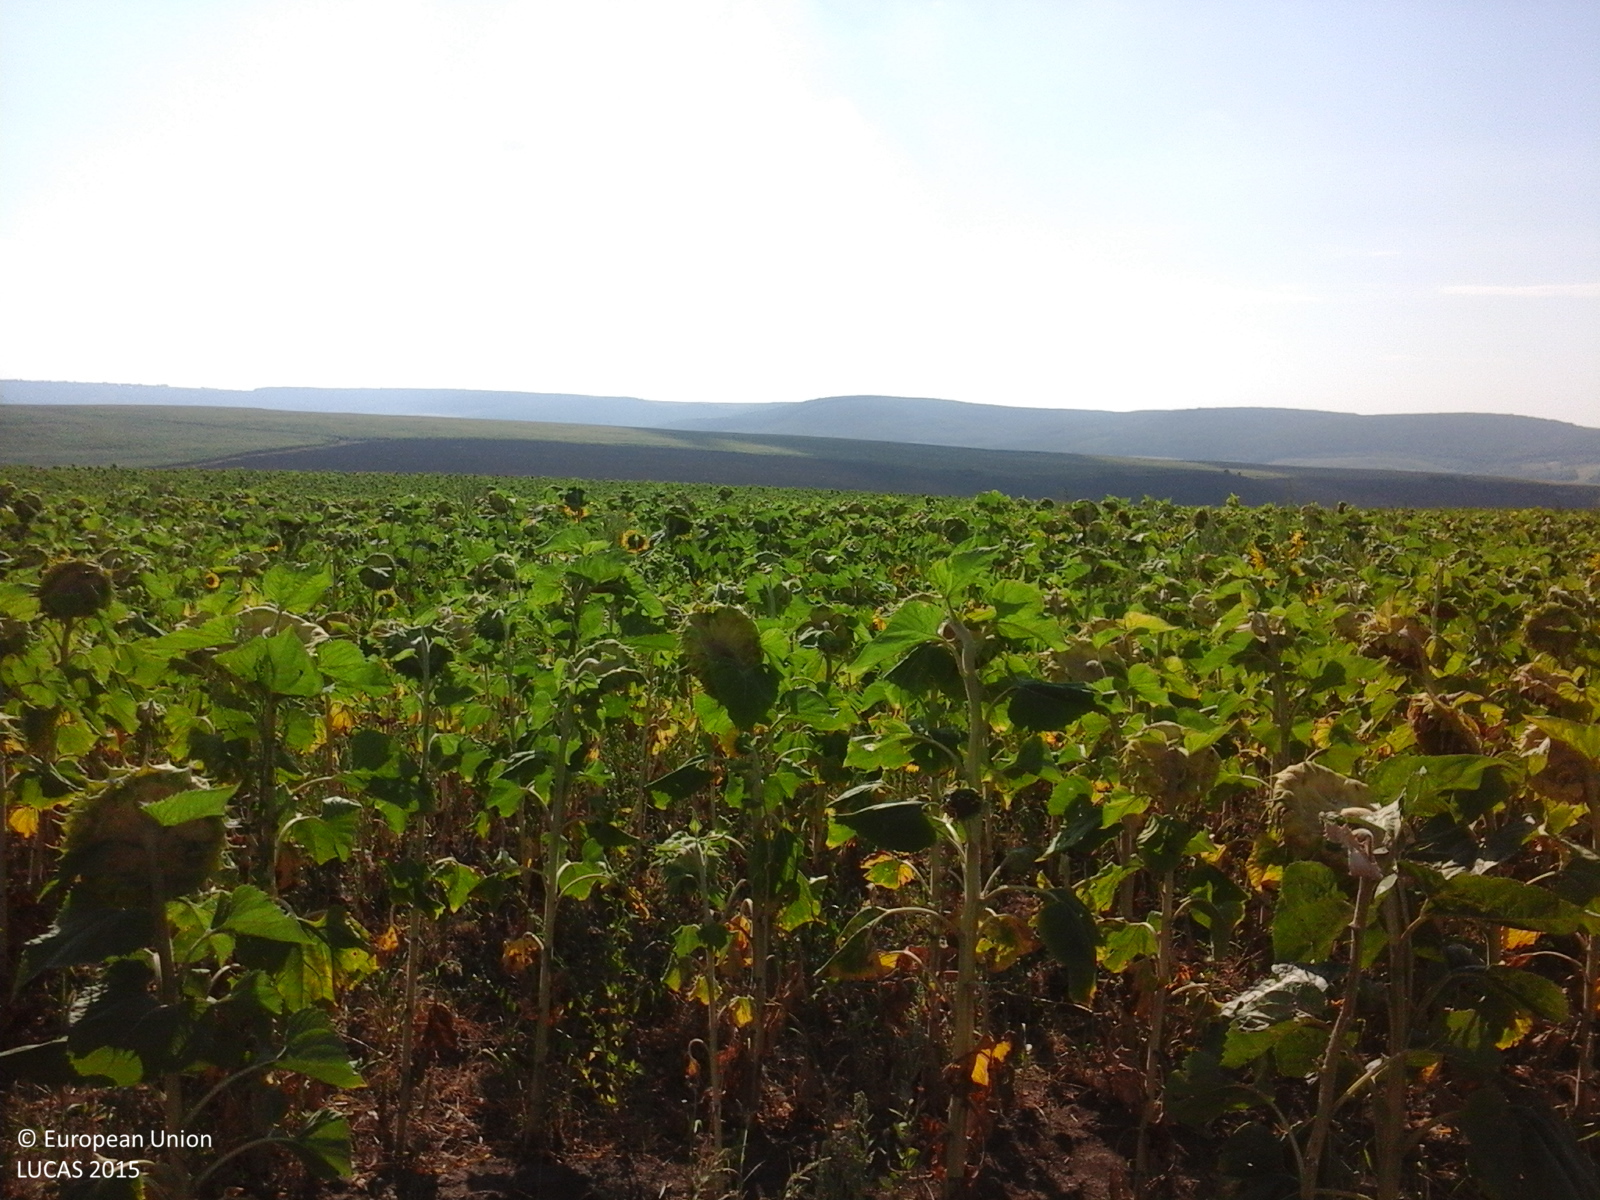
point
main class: Cropland
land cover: Sunflower
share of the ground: > 75 %
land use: Agriculture (excluding fallow land and kitchen gardens)
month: July
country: RO
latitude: 46.1350
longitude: 27.7850
